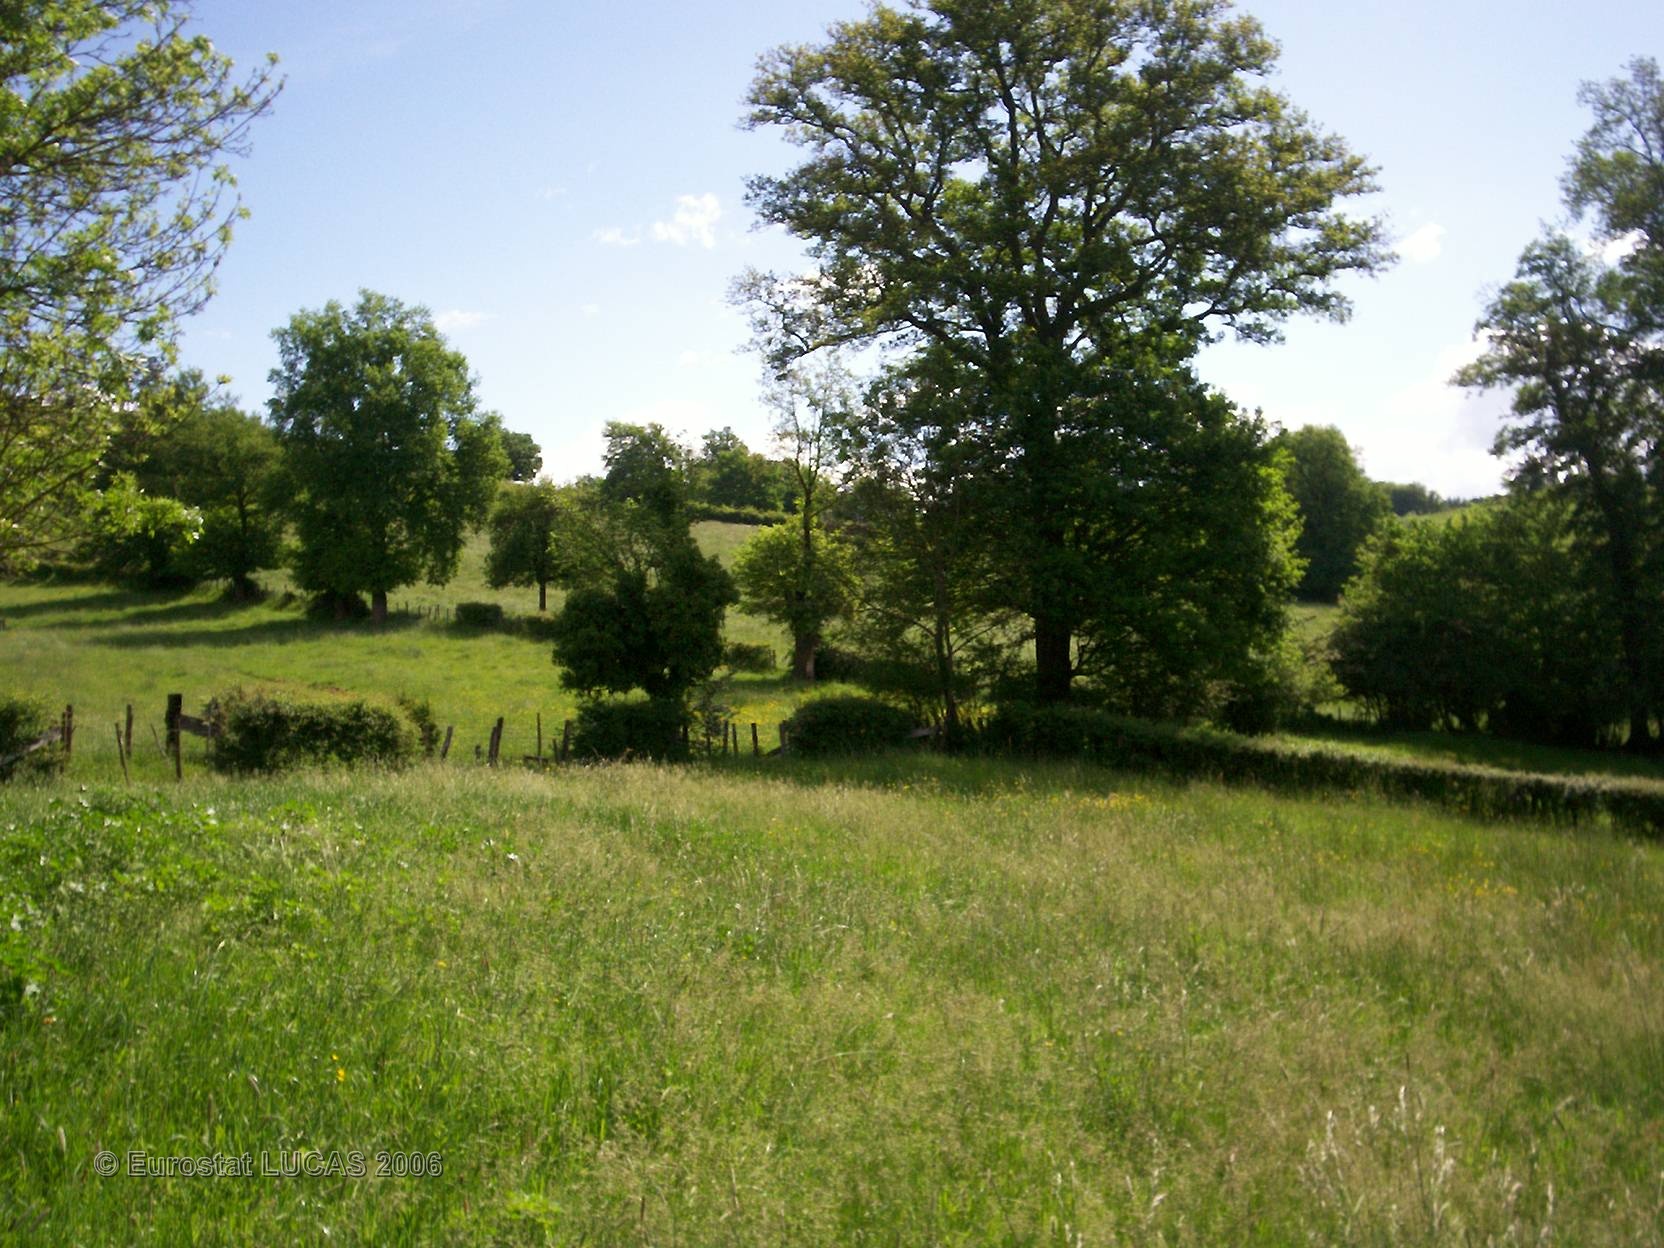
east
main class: Grassland
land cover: Grassland without tree/shrub cover
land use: Agriculture (excluding fallow land and kitchen gardens)
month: May
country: FR
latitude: 46.0645
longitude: 4.1456
